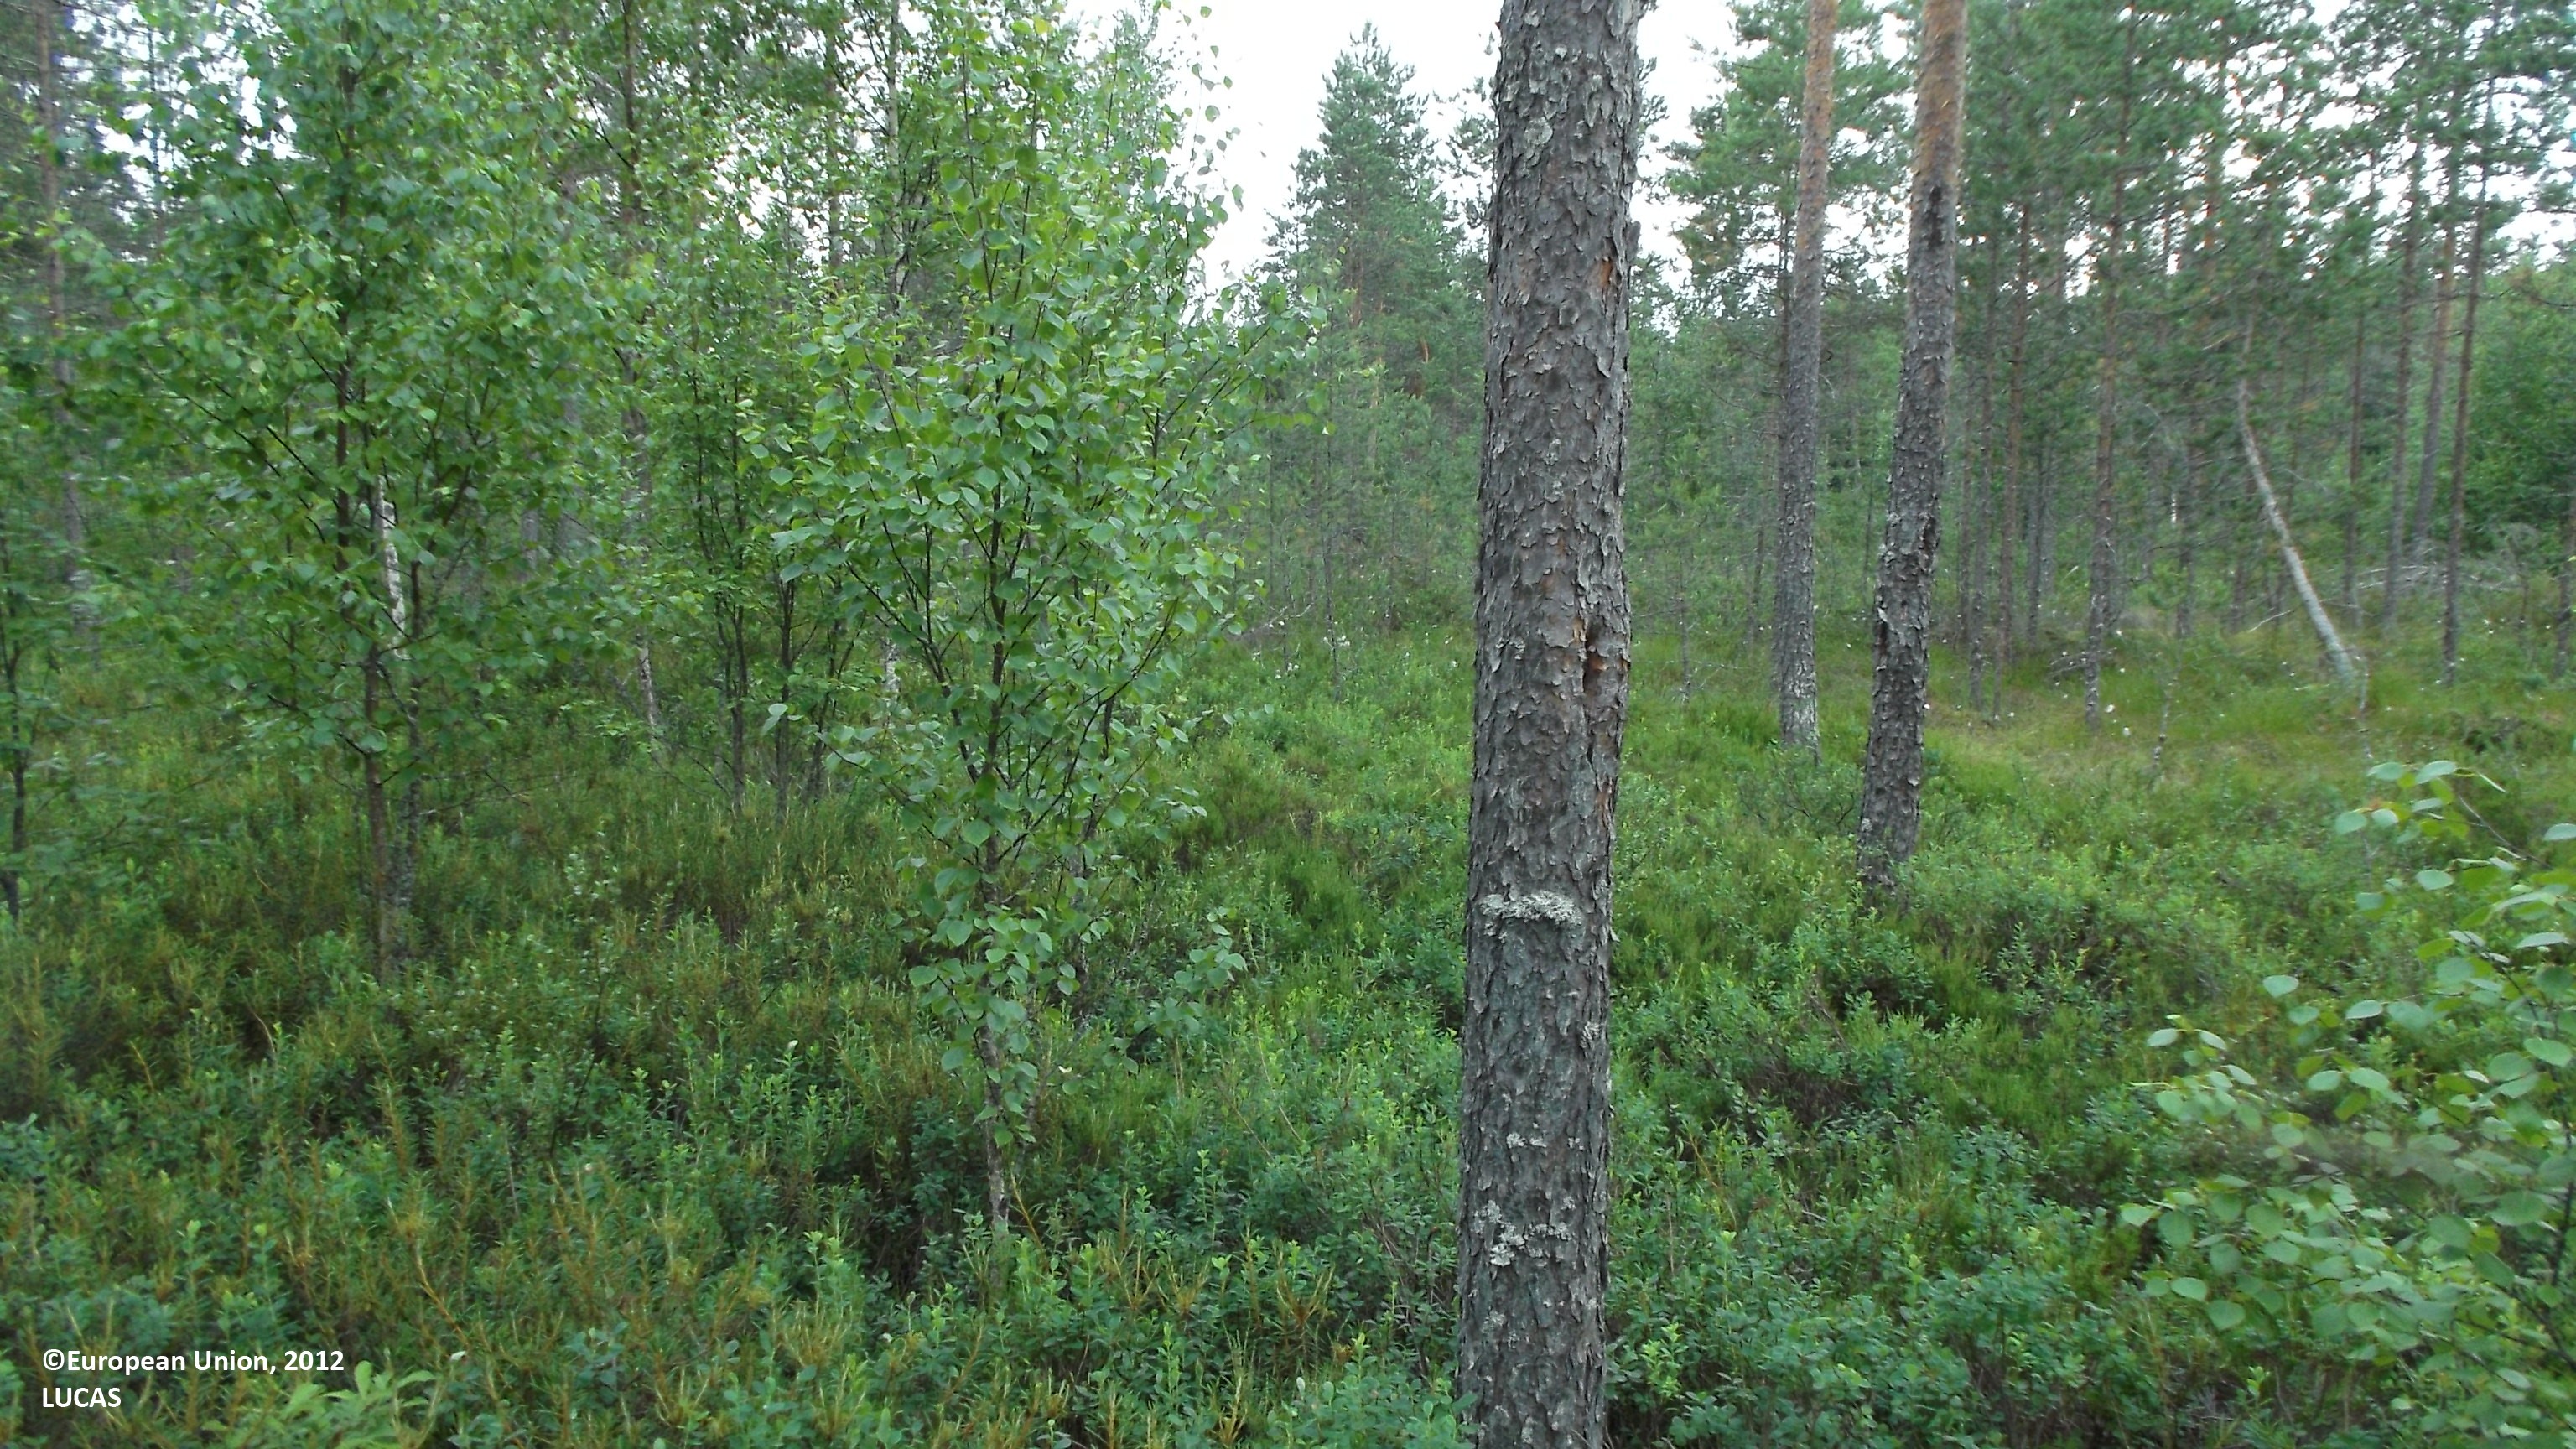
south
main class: Woodland
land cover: Pine dominated mixed woodland
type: boreal forest
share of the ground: 10 - 25 %
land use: Forestry
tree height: > 5 m
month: July
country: FI
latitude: 63.2658
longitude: 23.5137
